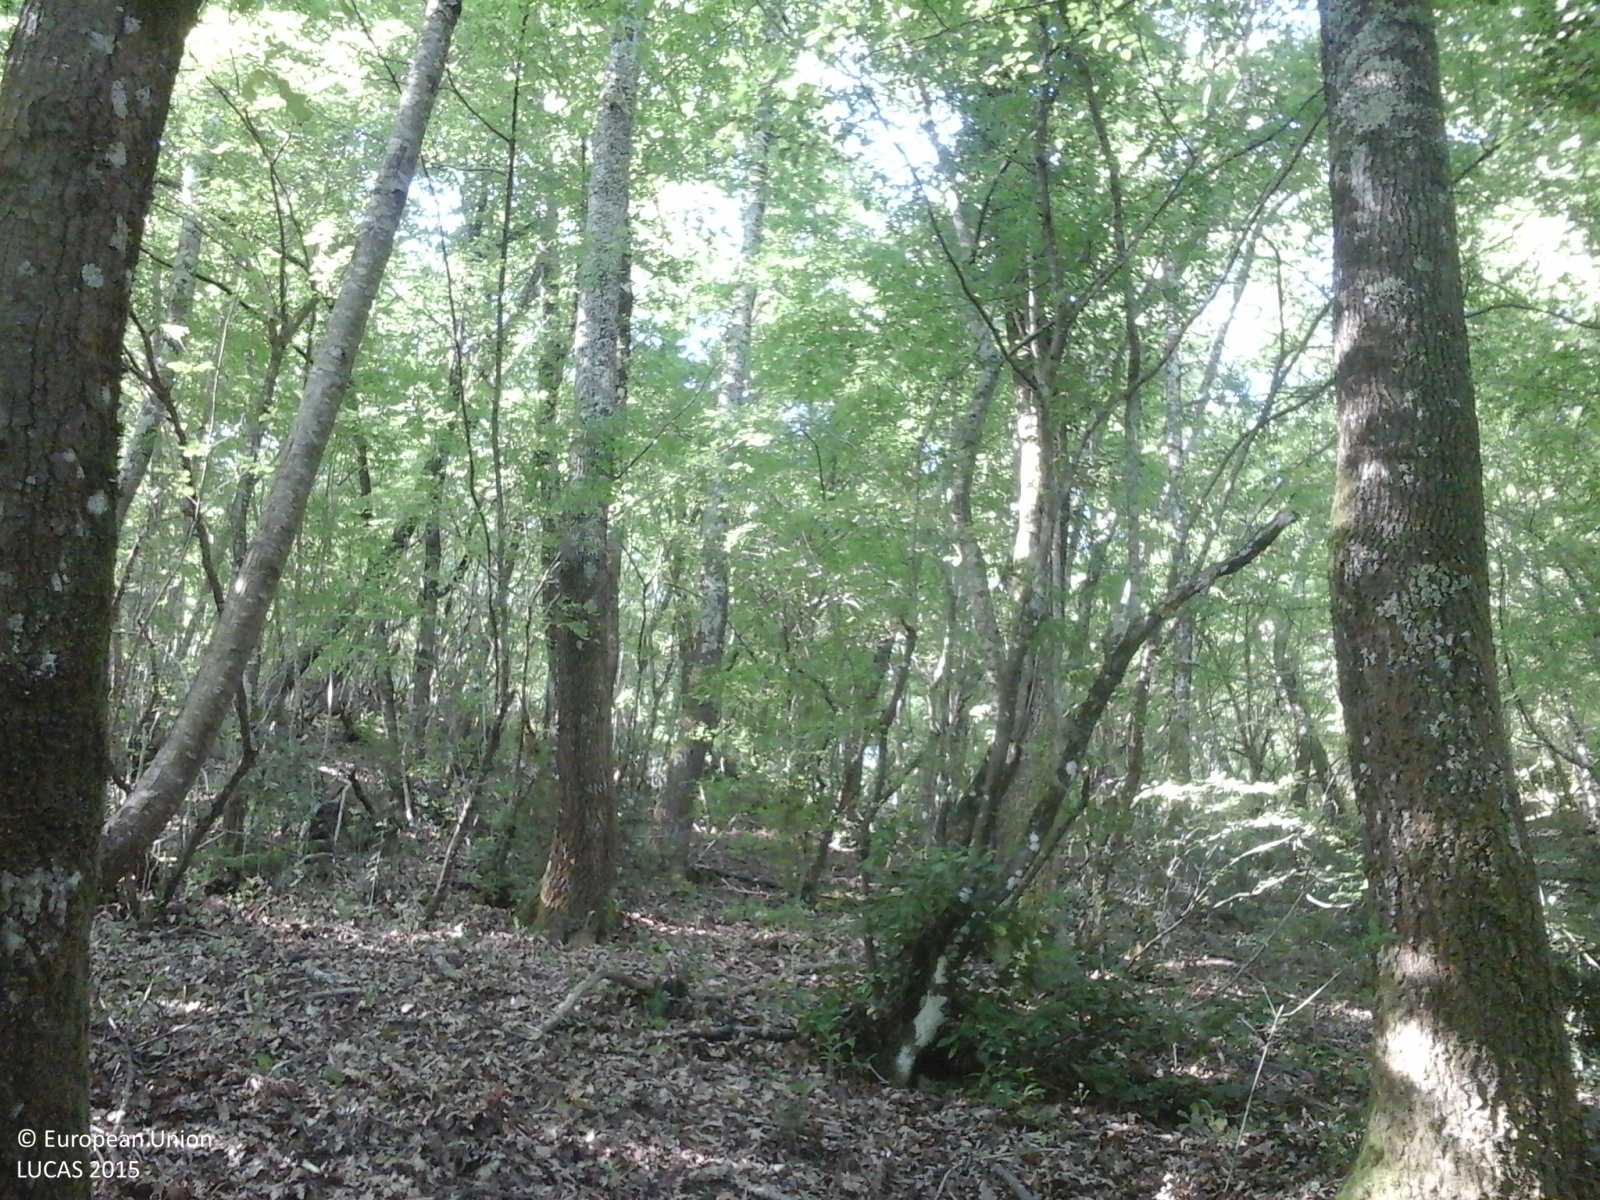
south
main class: Woodland
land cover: Broadleaved woodland
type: thermophilous deciduous forest
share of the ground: > 75 %
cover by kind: broadleaved forest trees 100 %
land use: Forestry
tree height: > 5 m
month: June
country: IT
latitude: 42.2160
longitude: 12.8612
